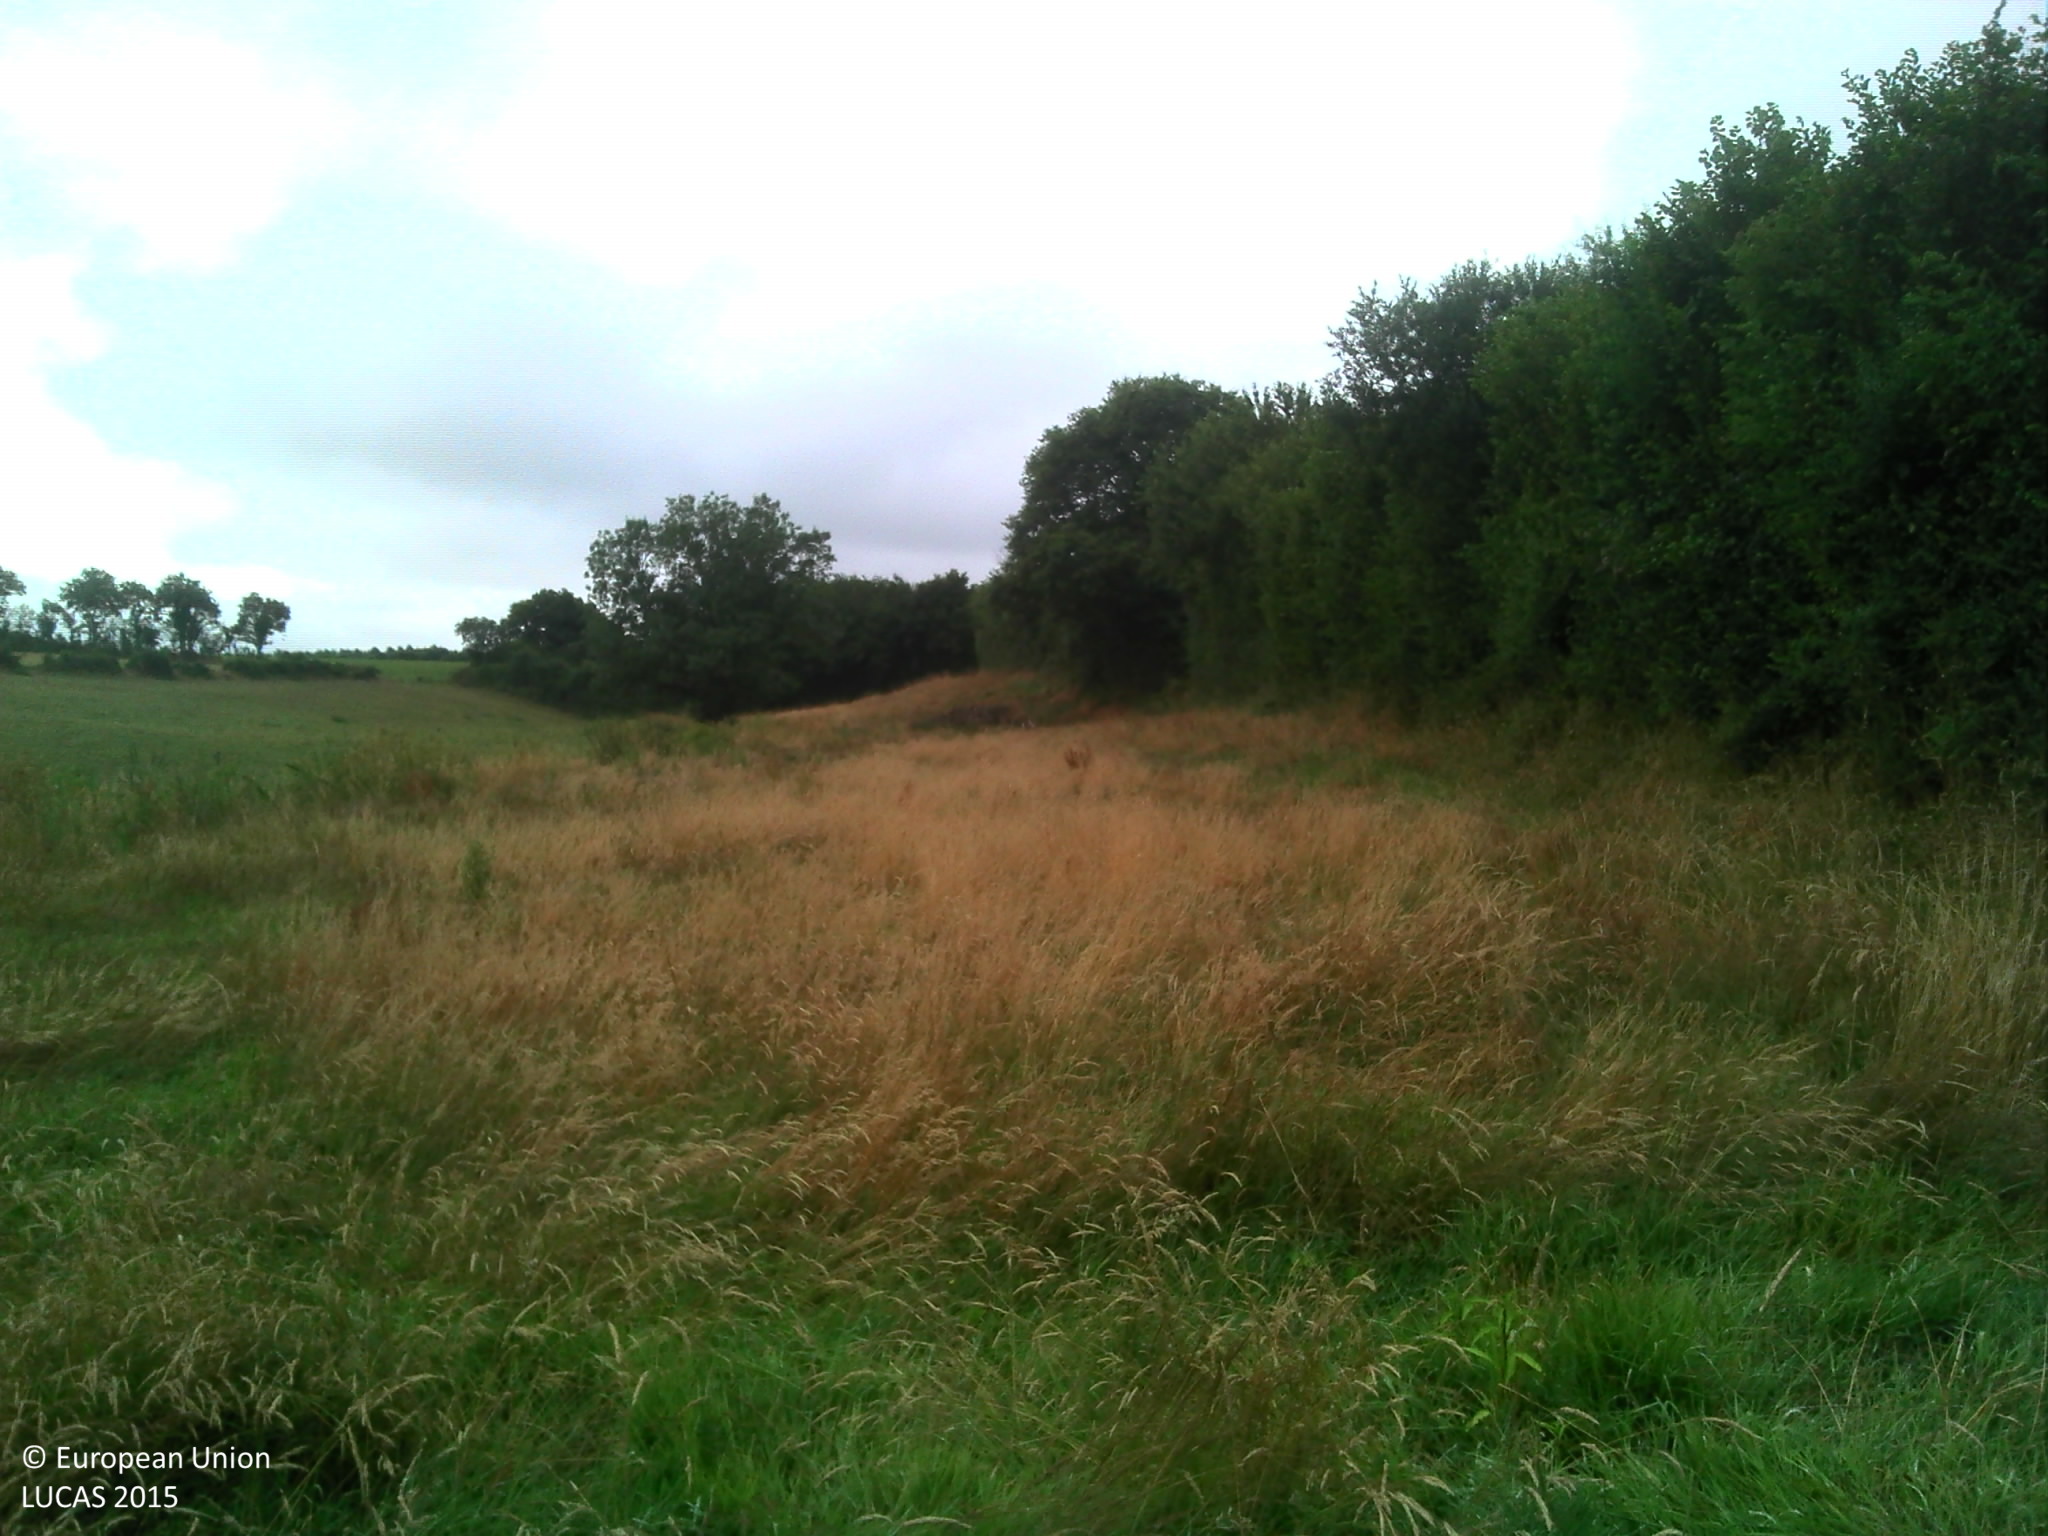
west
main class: Grassland
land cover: Grassland without tree/shrub cover
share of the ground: > 75 %
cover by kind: herbaceous plants 100 %
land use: Agriculture (excluding fallow land and kitchen gardens)
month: July
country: FR
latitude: 46.5385
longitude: -1.5789
